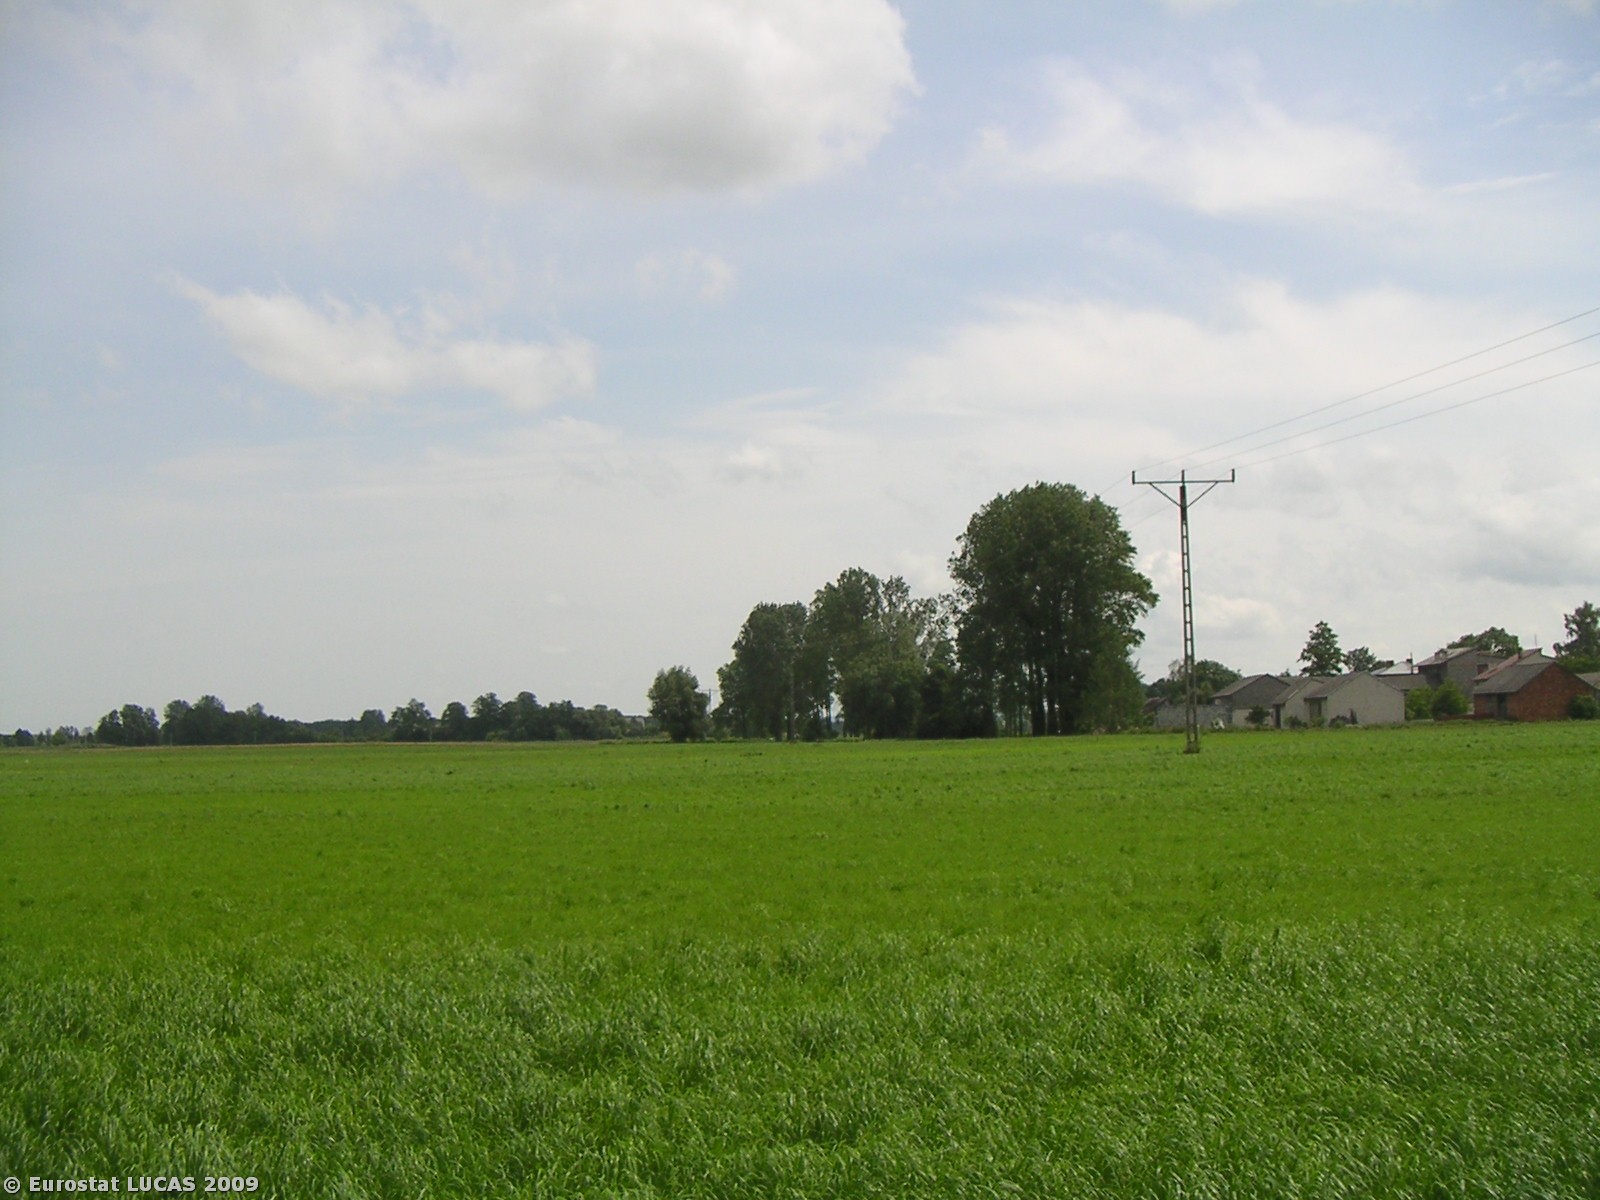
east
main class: Grassland
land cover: Grassland without tree/shrub cover
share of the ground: > 75 %
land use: Agriculture (excluding fallow land and kitchen gardens)
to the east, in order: Grassland without tree/shrub cover
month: June
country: PL
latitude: 50.4729
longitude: 19.7380
